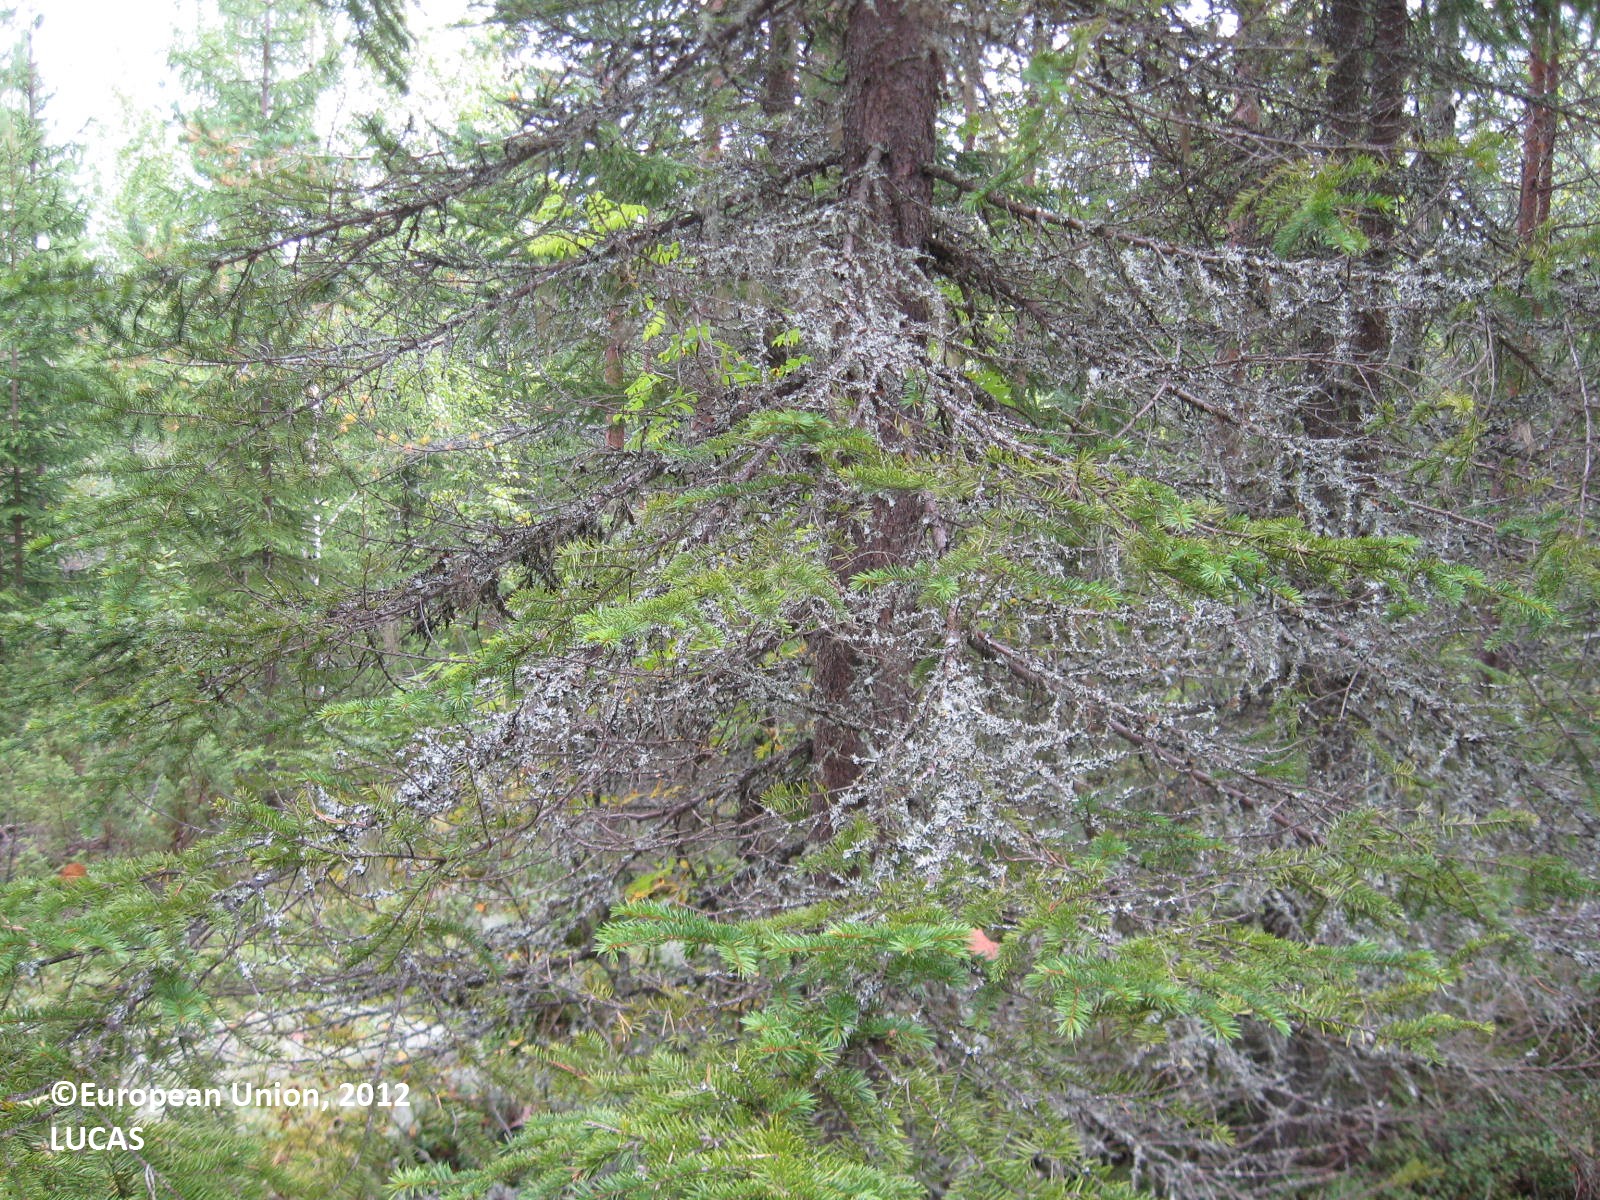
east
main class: Woodland
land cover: Pine dominated mixed woodland
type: boreal forest
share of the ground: > 75 %
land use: Forestry
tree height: > 5 m
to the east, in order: Pine dominated mixed woodland; Other mixed woodland; Spruce dominated coniferous woodland
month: August
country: FI
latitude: 63.5514
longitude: 29.8623
